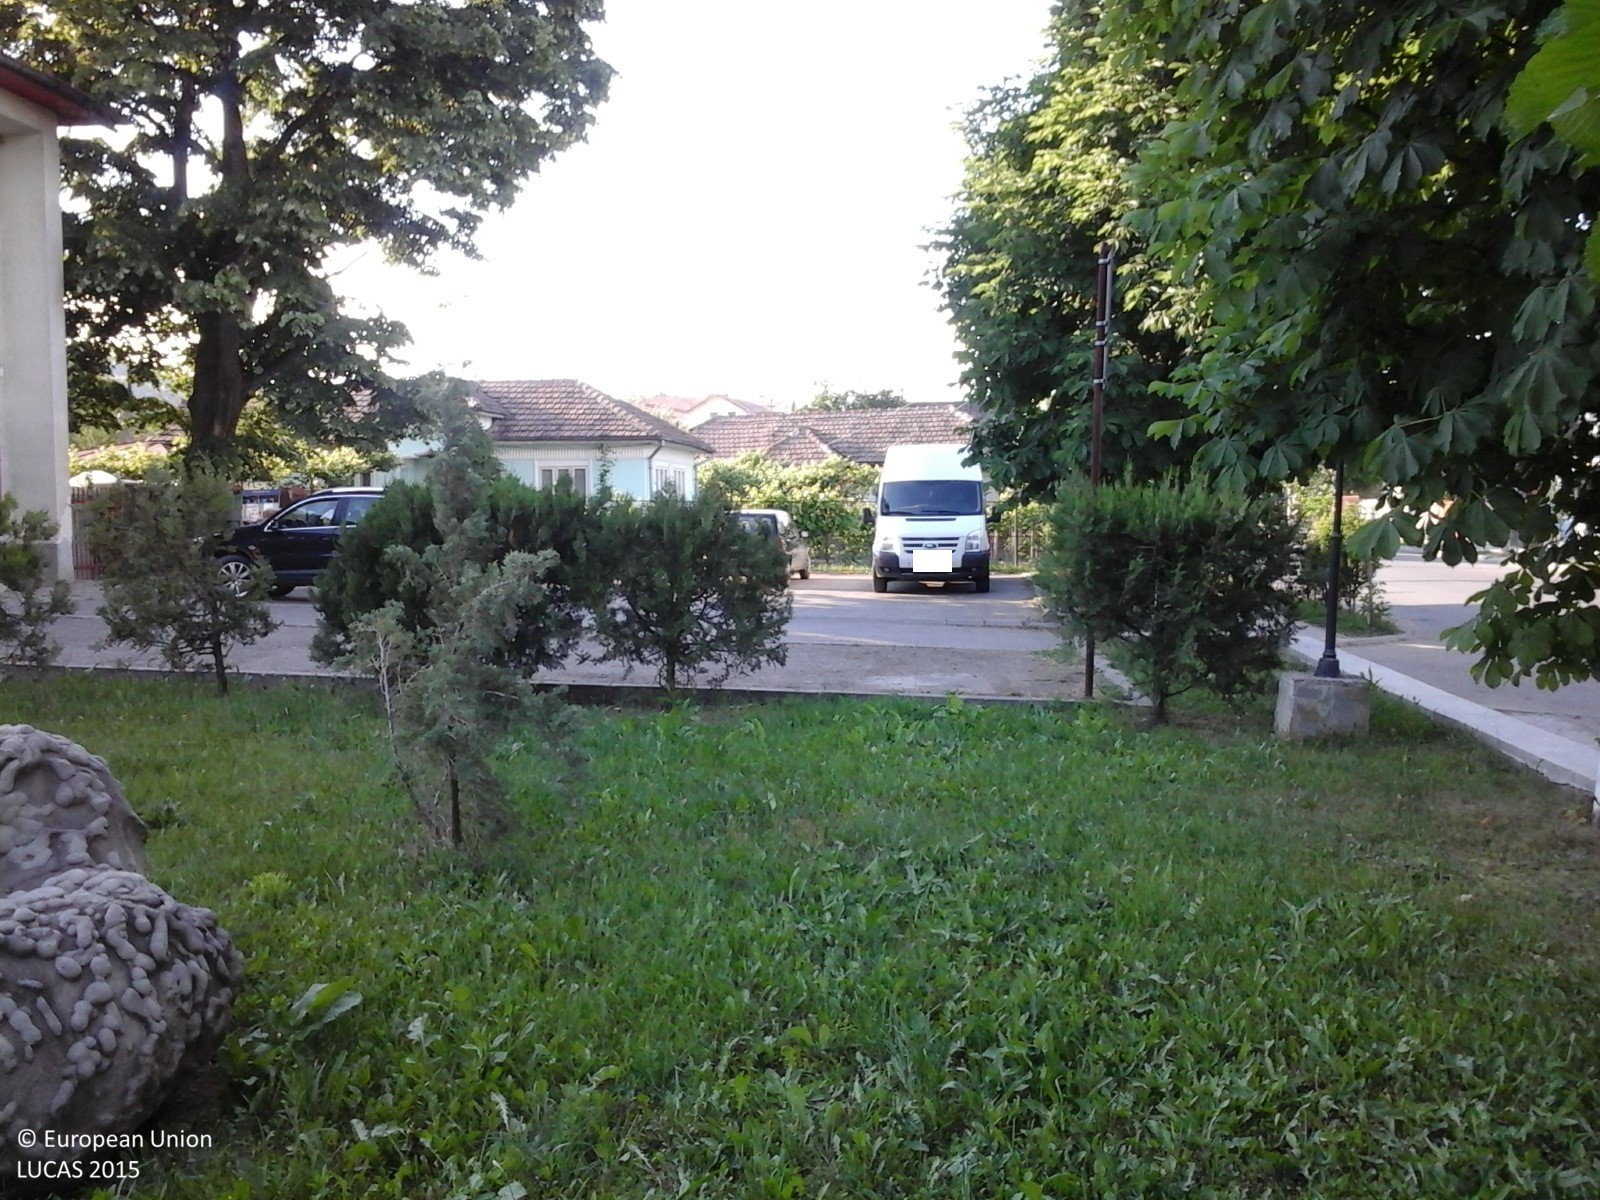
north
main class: Grassland
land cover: Grassland with sparse tree/shrub cover
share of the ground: > 75 %
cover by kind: herbaceous plants 95 %, broadleaved forest trees 5 %
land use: Amenities, museums, leisure
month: May
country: RO
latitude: 45.3194
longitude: 26.3598
